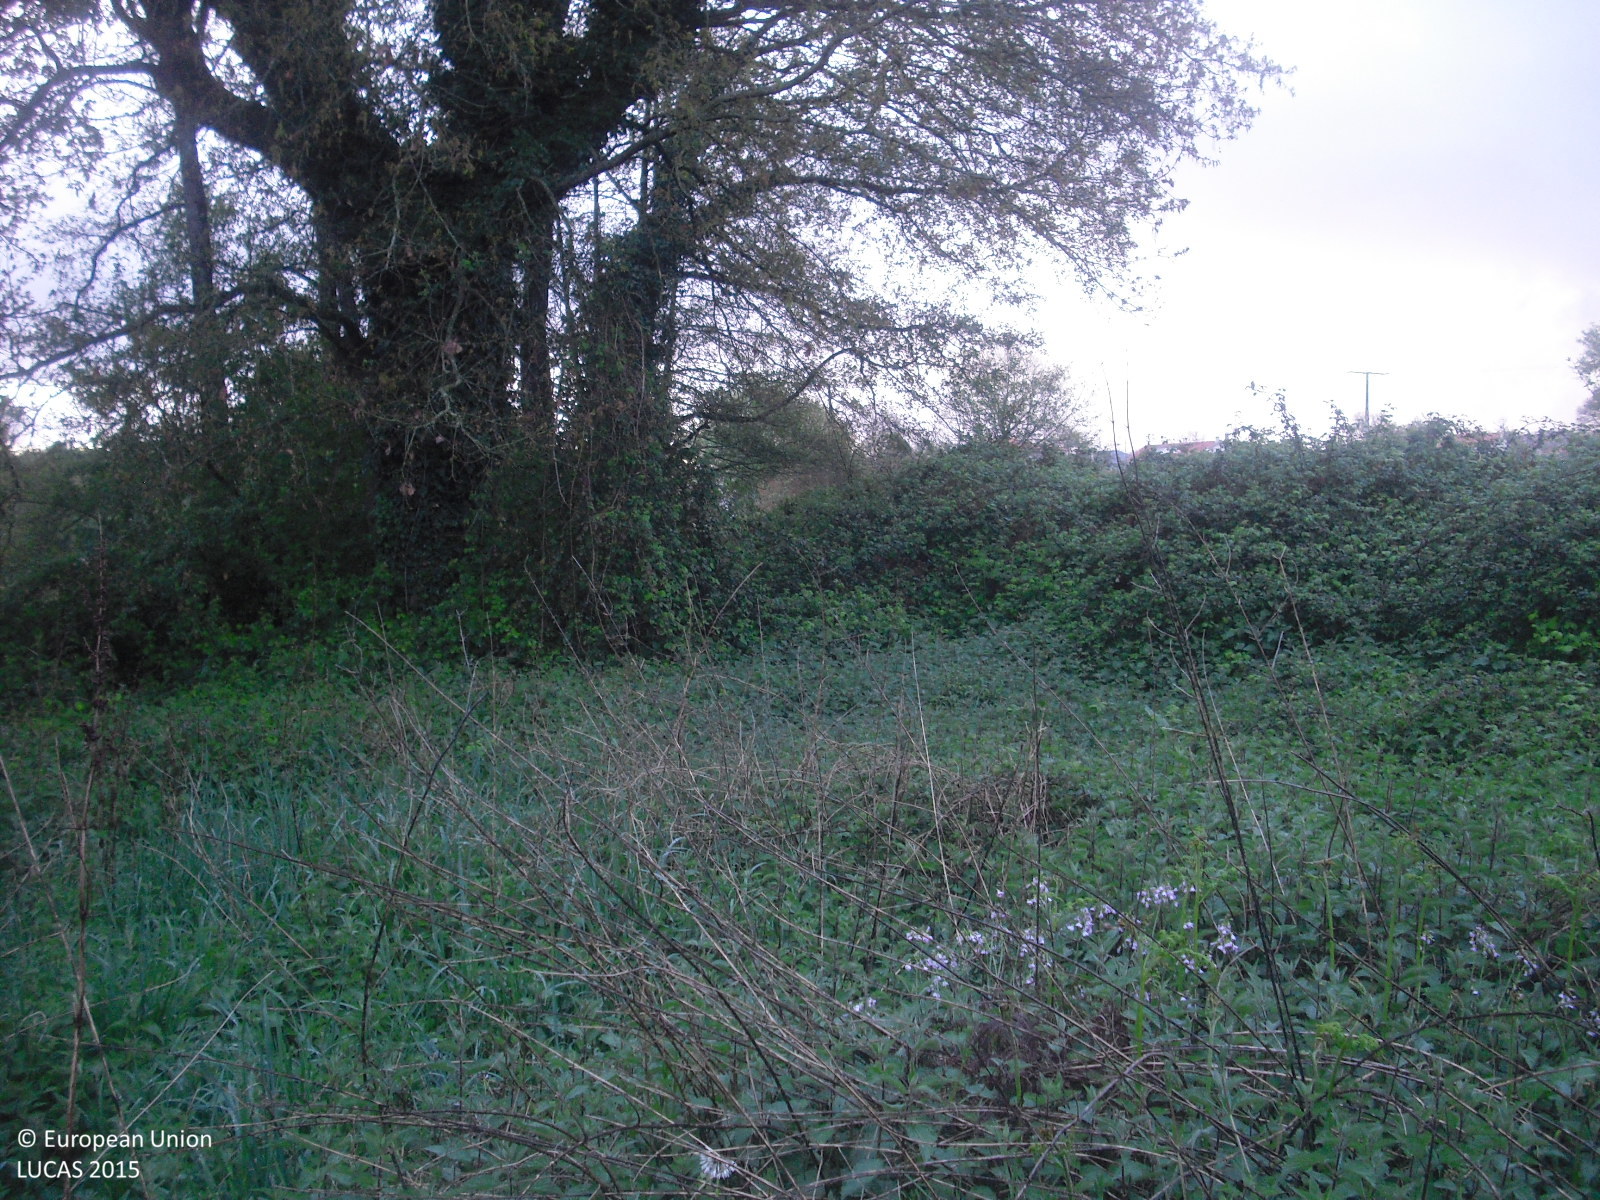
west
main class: Grassland
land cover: Grassland with sparse tree/shrub cover
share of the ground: > 75 %
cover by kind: herbaceous plants 85 %, shrubs 10 %, broadleaved forest trees 5 %
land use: Semi-natural and natural areas not in use
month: April
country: ES
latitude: 42.1071
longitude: -7.8379
